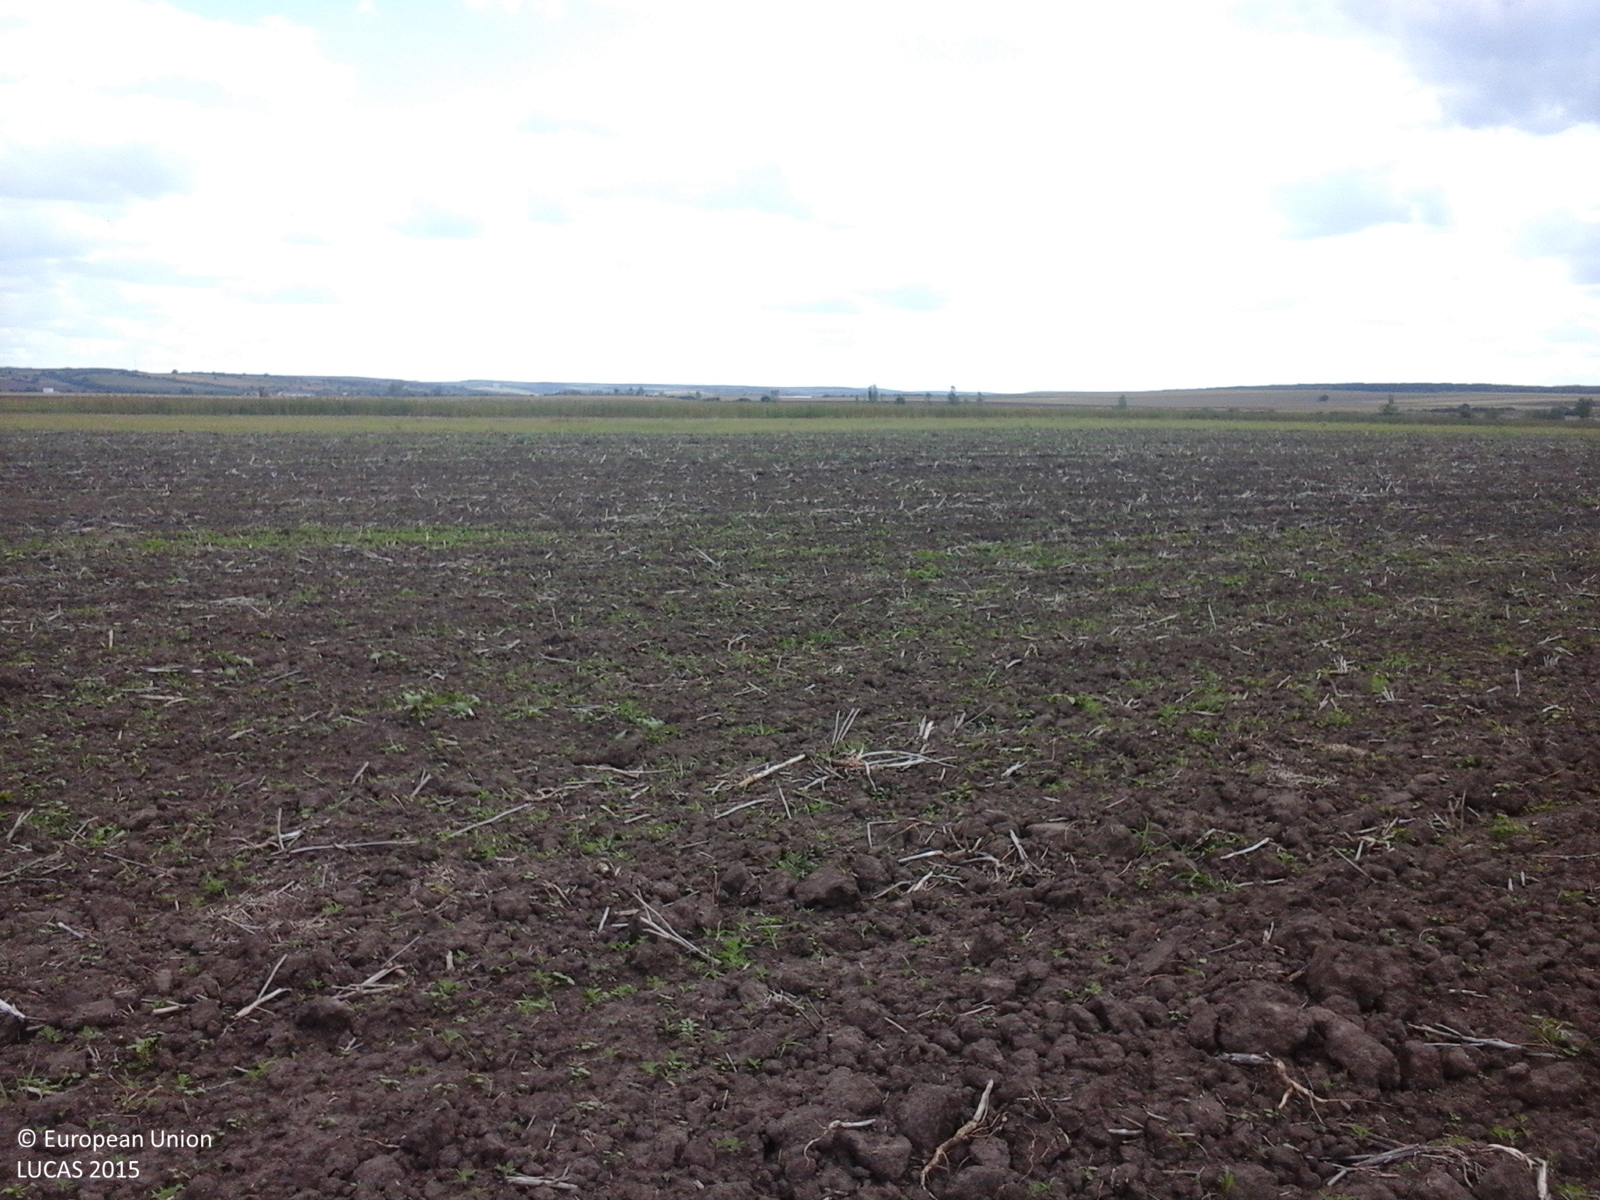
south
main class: Cropland
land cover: Rape and turnip rape
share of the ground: < 10 %
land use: Agriculture (excluding fallow land and kitchen gardens)
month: September
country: RO
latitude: 47.5084
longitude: 22.6597
